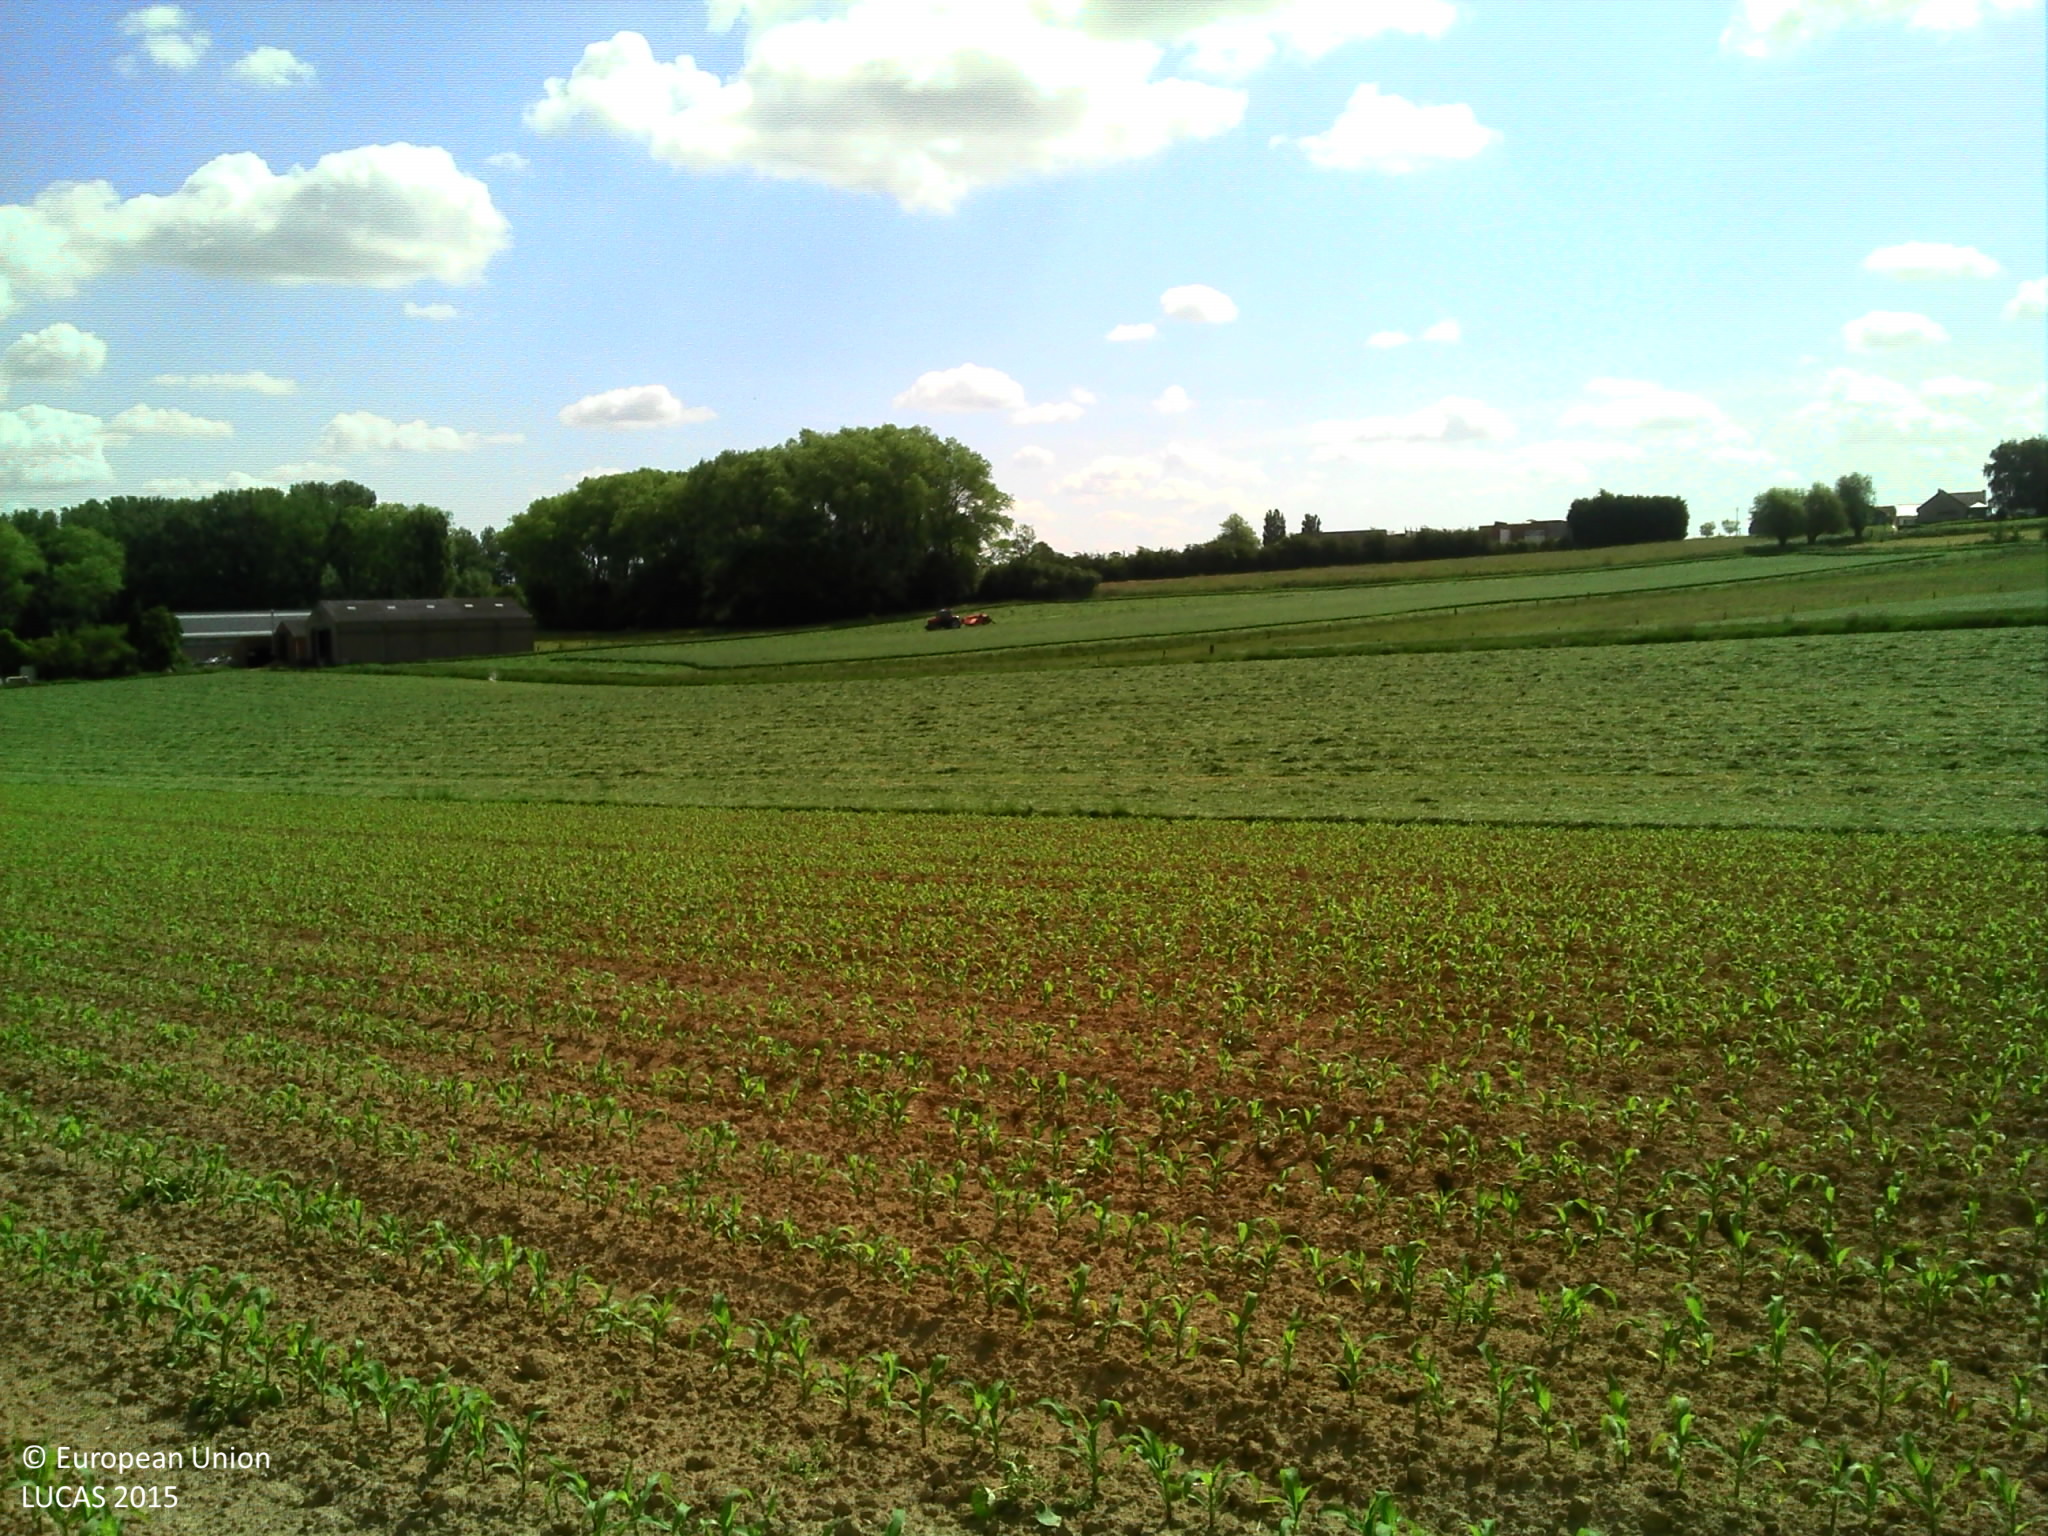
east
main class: Cropland
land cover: Maize
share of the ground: < 10 %
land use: Agriculture (excluding fallow land and kitchen gardens)
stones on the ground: < 10 %
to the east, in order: Maize; Temporary grasslands; Grass margins; Tracks; Grass margins; Fences; Grassland without tree/shrub cover; Fences; Ditches and canals; Temporary grasslands
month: June
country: BE
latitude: 50.7921
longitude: 2.8820
